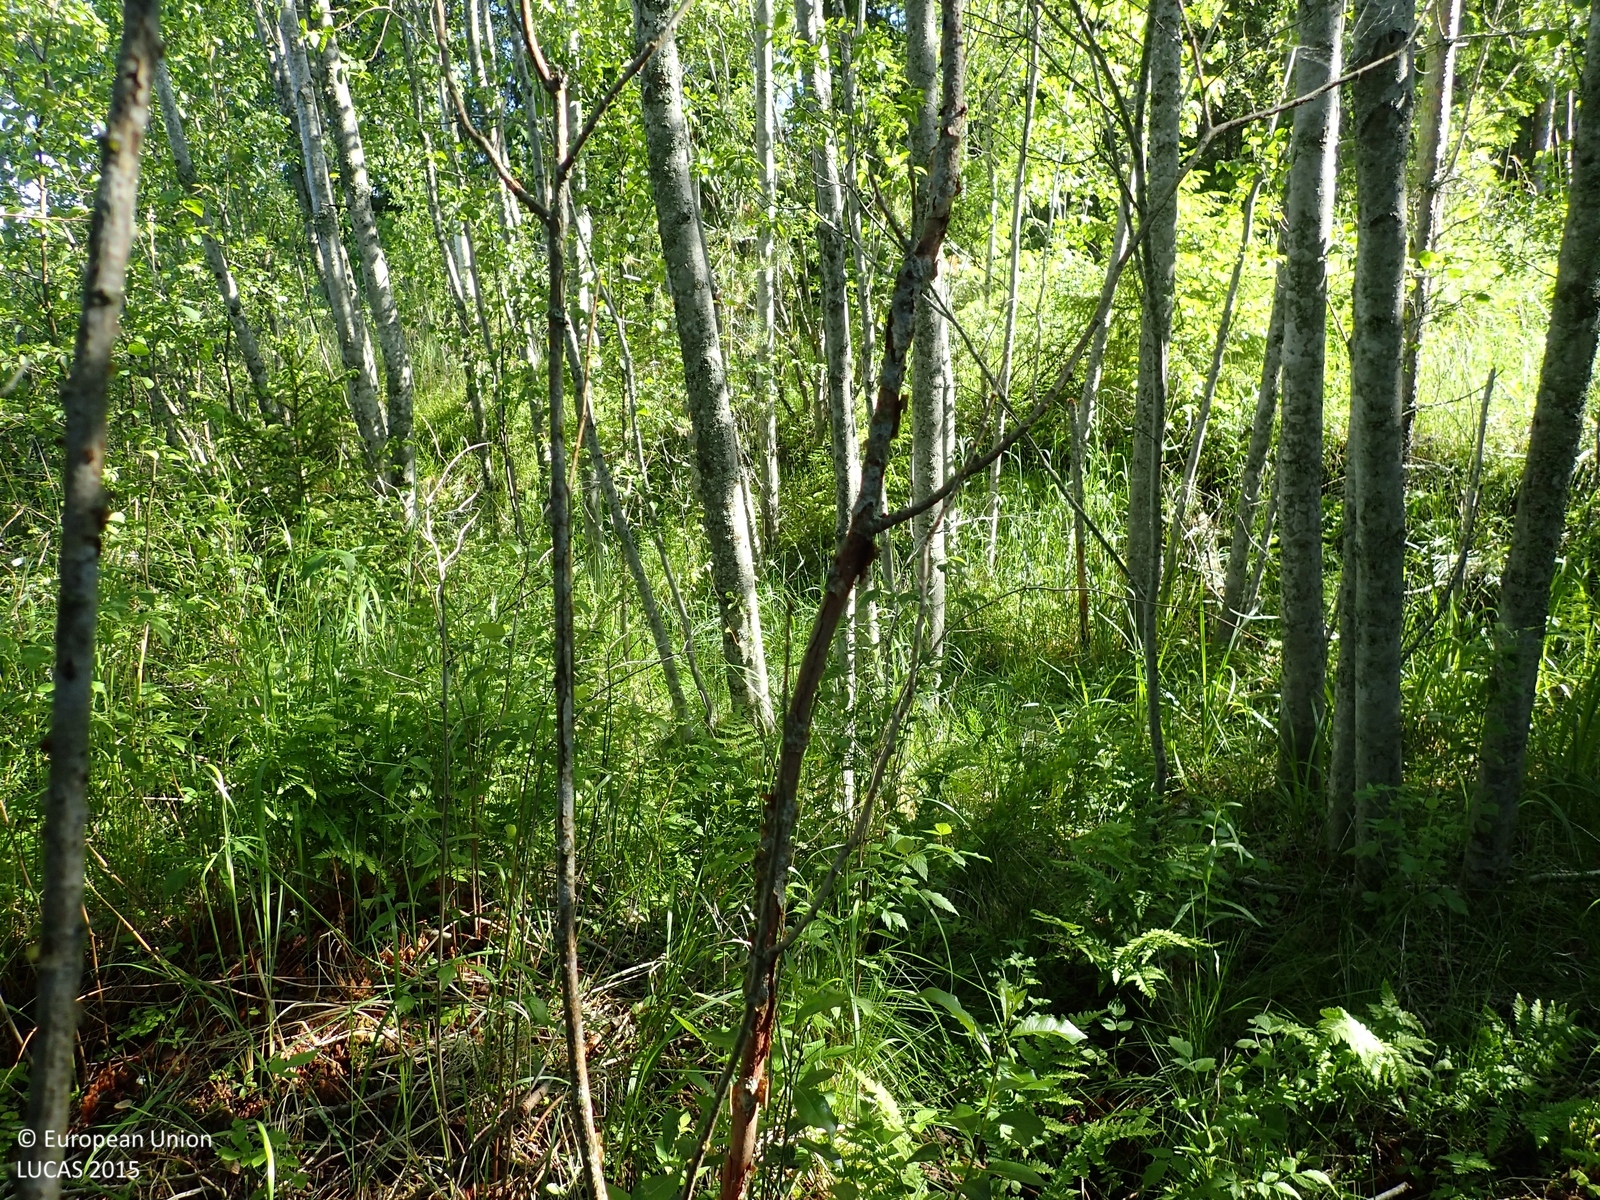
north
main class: Woodland
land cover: Broadleaved woodland
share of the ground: > 75 %
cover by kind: broadleaved forest trees 75 %, herbaceous plants 25 %
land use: Forestry
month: June
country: FI
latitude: 62.2848
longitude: 21.4351
